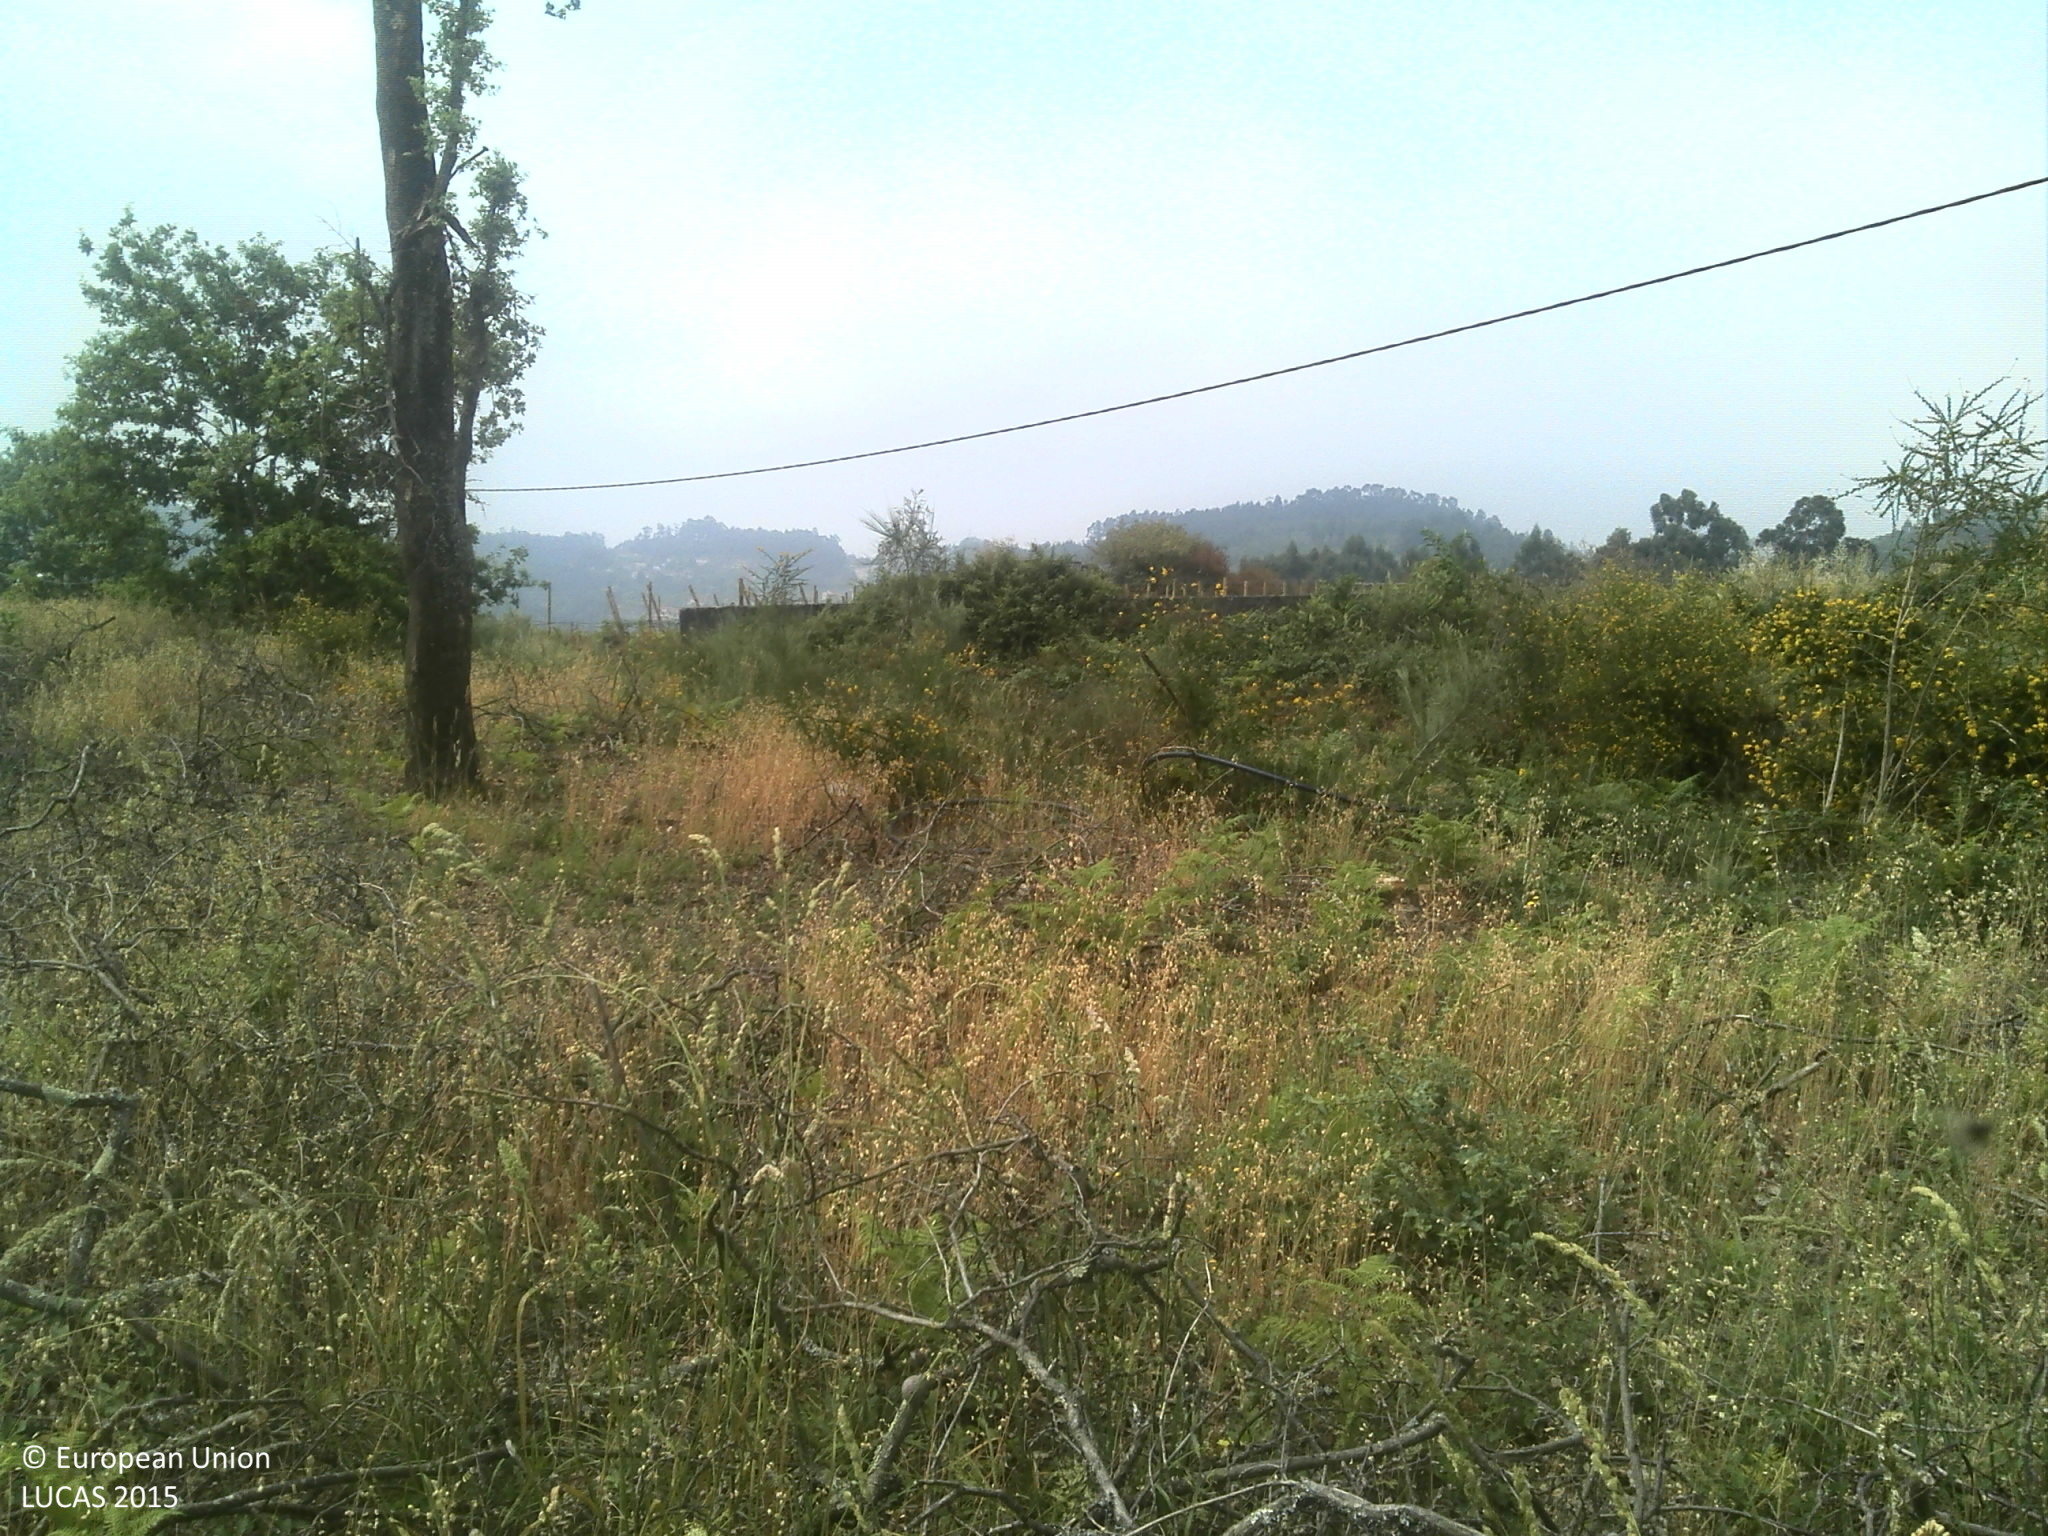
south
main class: Shrubland
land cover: Shrubland without tree cover
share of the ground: 50 - 75 %
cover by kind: shrubs 70 %, herbaceous plants 20 %, consolidated bare surface 5 %, unconsolidated bare surface 5 %
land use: Forestry
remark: Clear cut
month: June
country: PT
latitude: 41.3482
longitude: -8.2521
